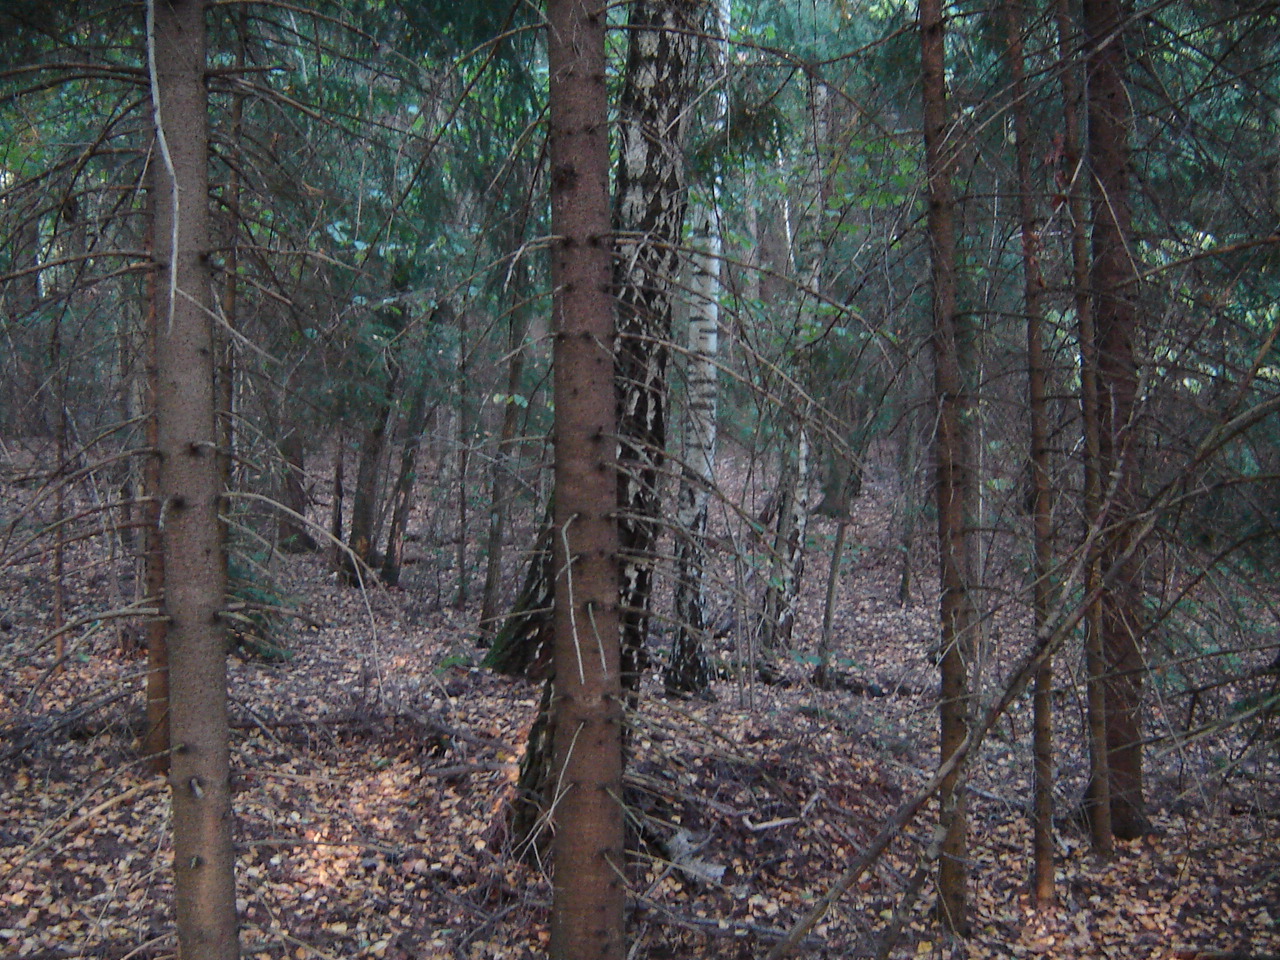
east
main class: Woodland
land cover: Pine dominated mixed woodland
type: hemiboreal forest and nemoral coniferous forest and mixed broadleaved-coniferous forest
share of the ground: > 75 %
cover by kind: coniferous forest trees 70 %, broadleaved forest trees 25 %, unconsolidated bare surface 5 %
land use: Forestry
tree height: > 5 m
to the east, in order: Pine dominated mixed woodland; Tracks; Spruce dominated mixed woodland
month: August
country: LT
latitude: 54.7161
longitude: 24.9695
